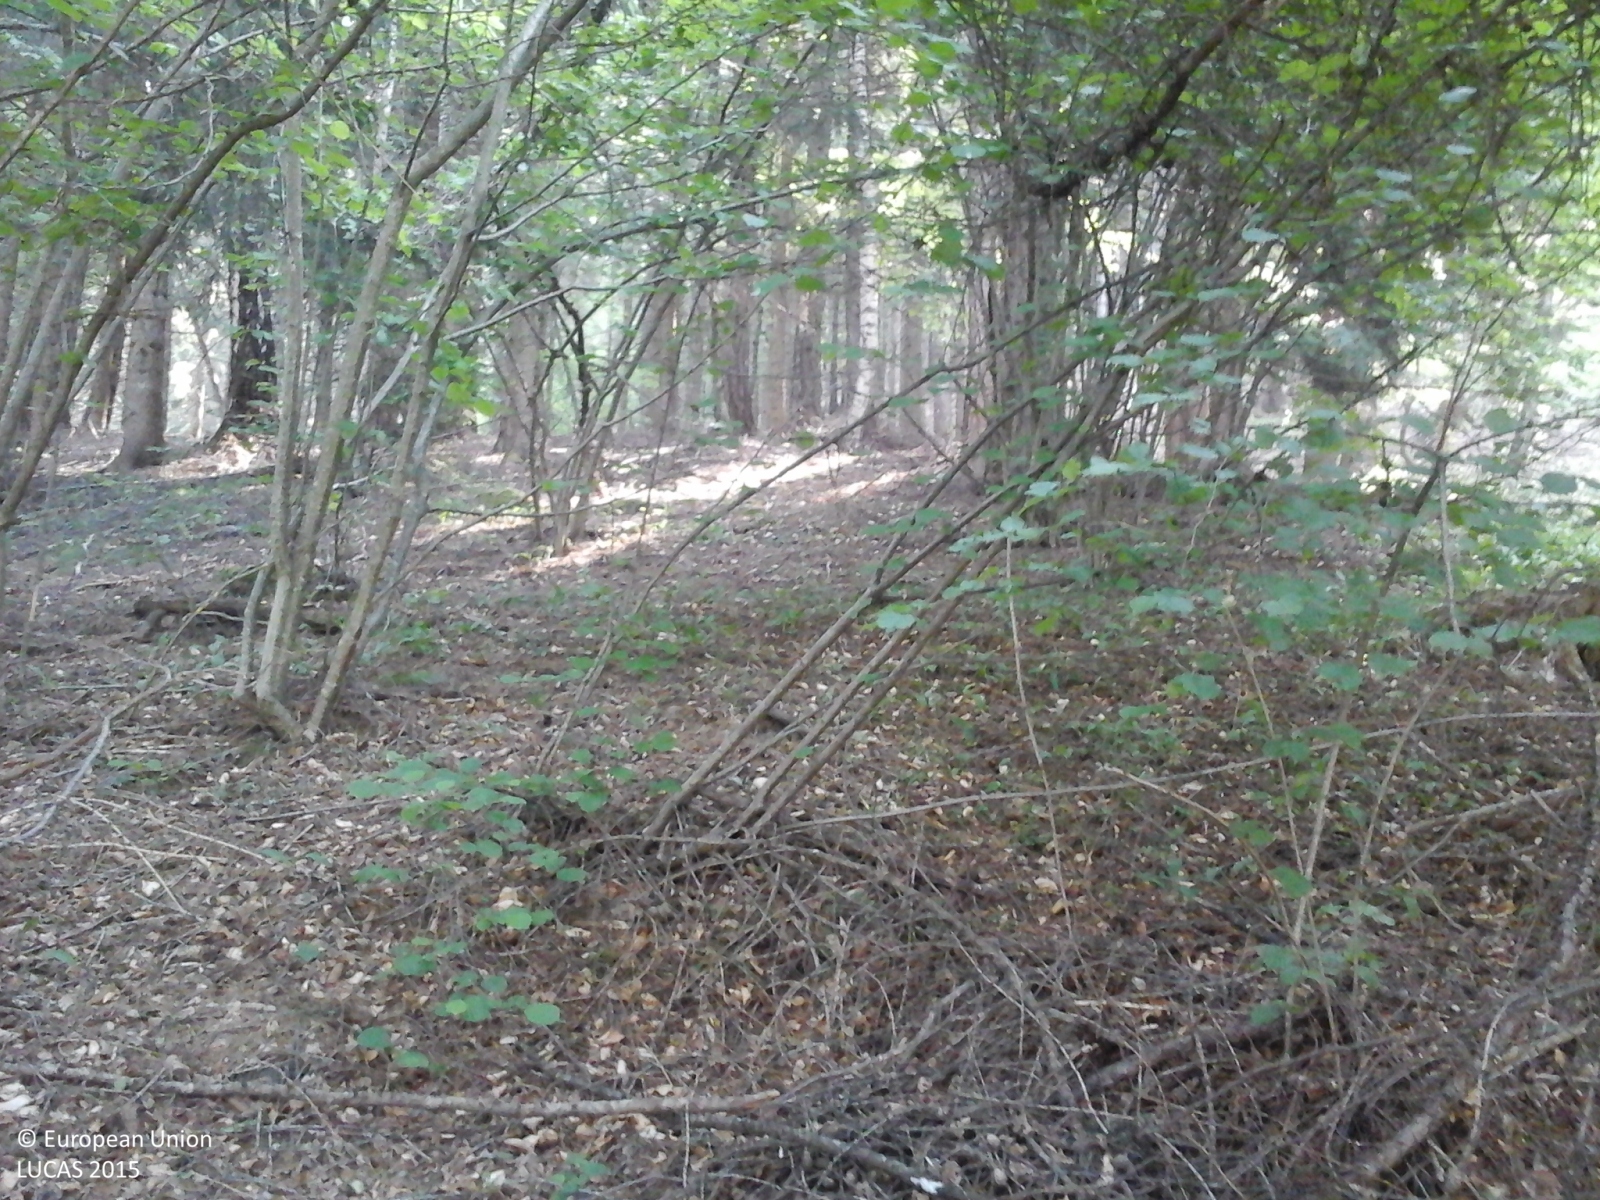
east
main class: Woodland
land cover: Spruce dominated mixed woodland
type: alpine coniferous forest
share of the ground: > 75 %
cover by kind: coniferous forest trees 70 %, broadleaved forest trees 30 %
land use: Forestry
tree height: > 5 m
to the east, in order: Spruce dominated mixed woodland; Tracks; Spruce dominated mixed woodland; Tracks; Spruce dominated mixed woodland; Tracks; Spruce dominated mixed woodland
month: June
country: IT
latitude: 46.7763
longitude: 11.2428
